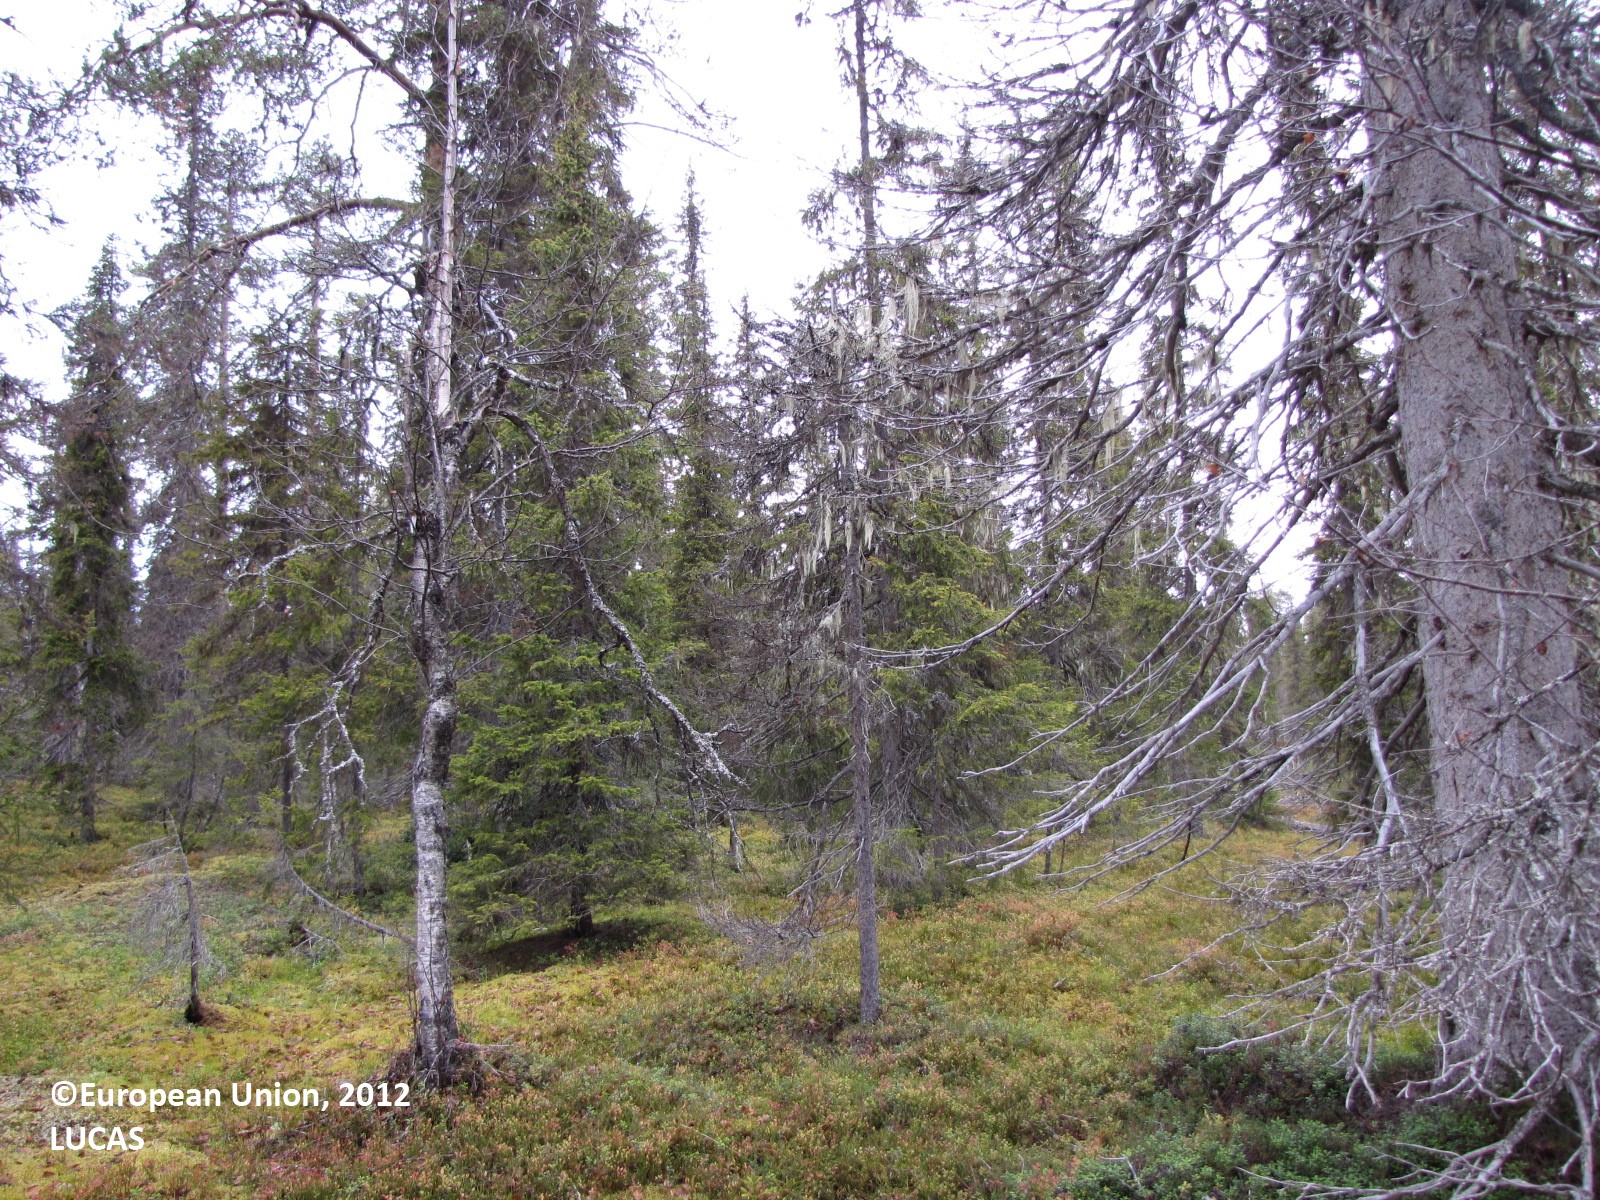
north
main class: Woodland
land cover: Spruce dominated coniferous woodland
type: boreal forest
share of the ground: 25 - 50 %
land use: Forestry
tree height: > 5 m
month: September
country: FI
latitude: 67.7597
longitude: 24.2039
